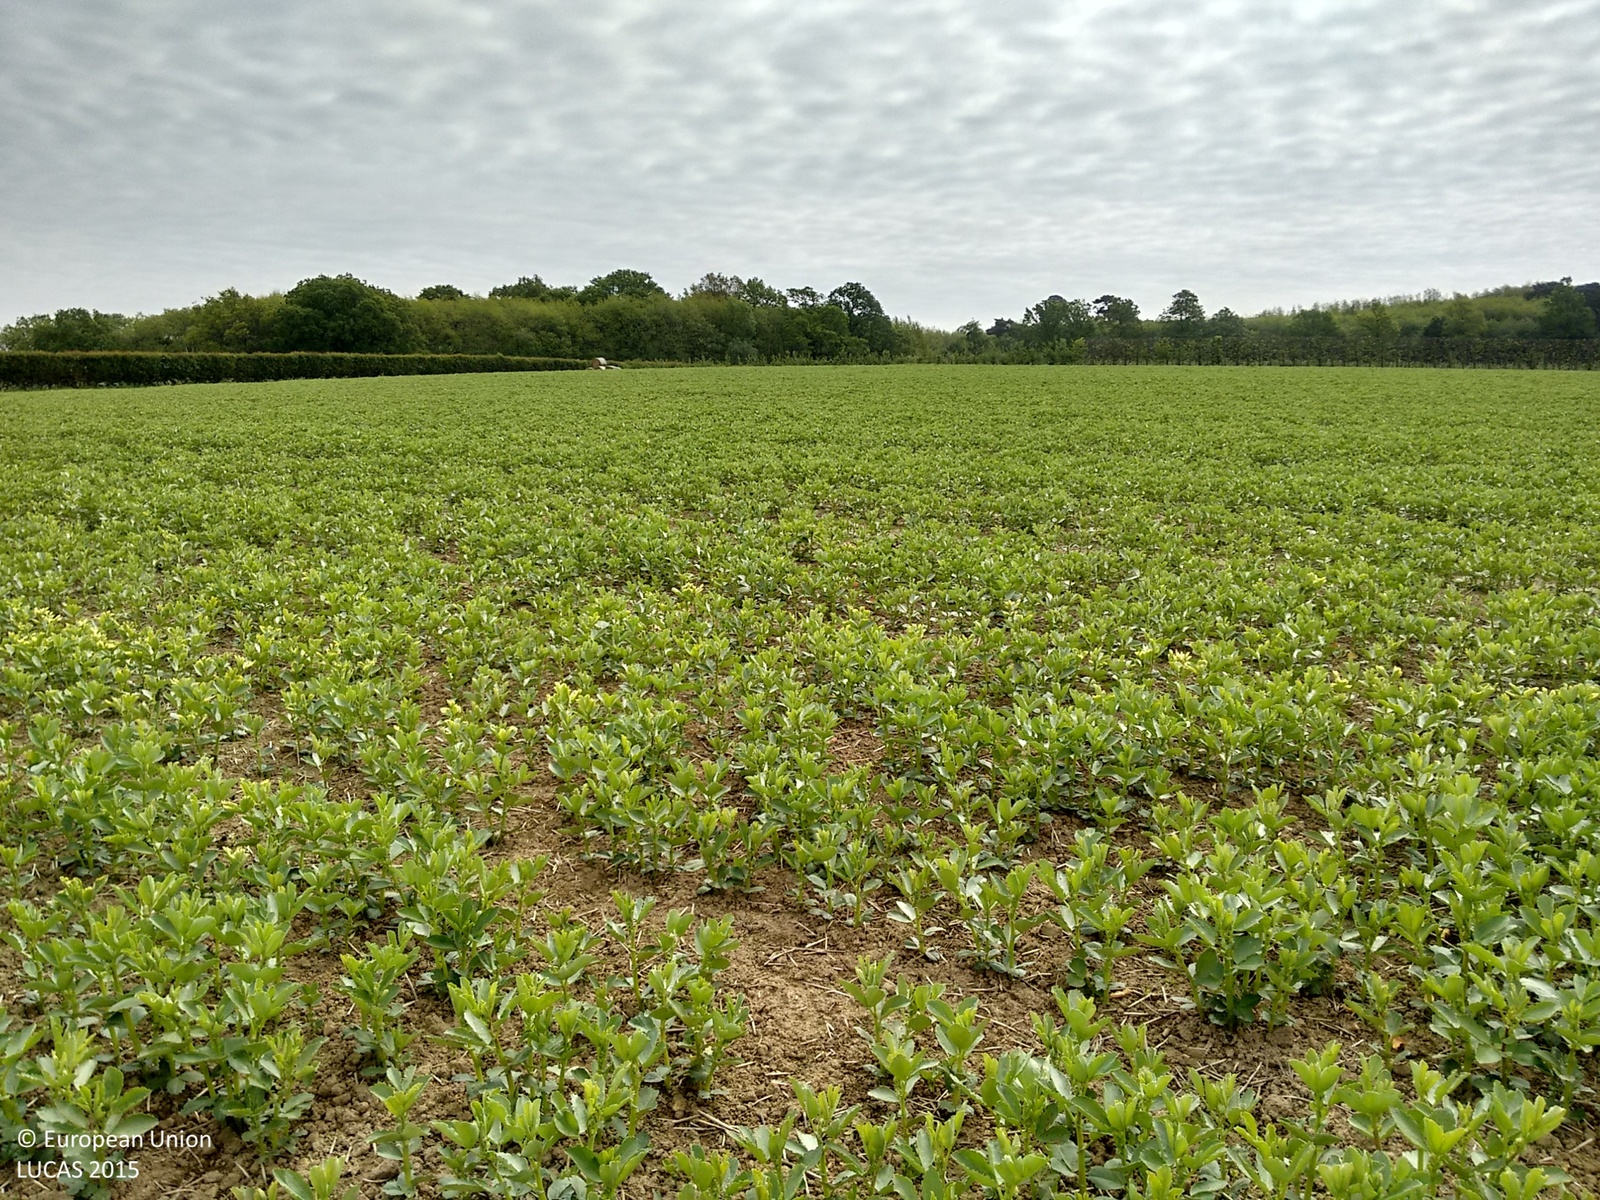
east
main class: Cropland
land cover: Dry pulses
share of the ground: > 75 %
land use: Agriculture (excluding fallow land and kitchen gardens)
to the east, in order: Dry pulses; Managed hedges; Apple fruit; Fences; Managed hedges; Other non-permanent industrial crops; Fences; Managed hedges; Grass margins; Tracks; Broadleaved woodland; Tracks; Broadleaved woodland
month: May
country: GB
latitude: 51.1373
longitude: 0.4099
